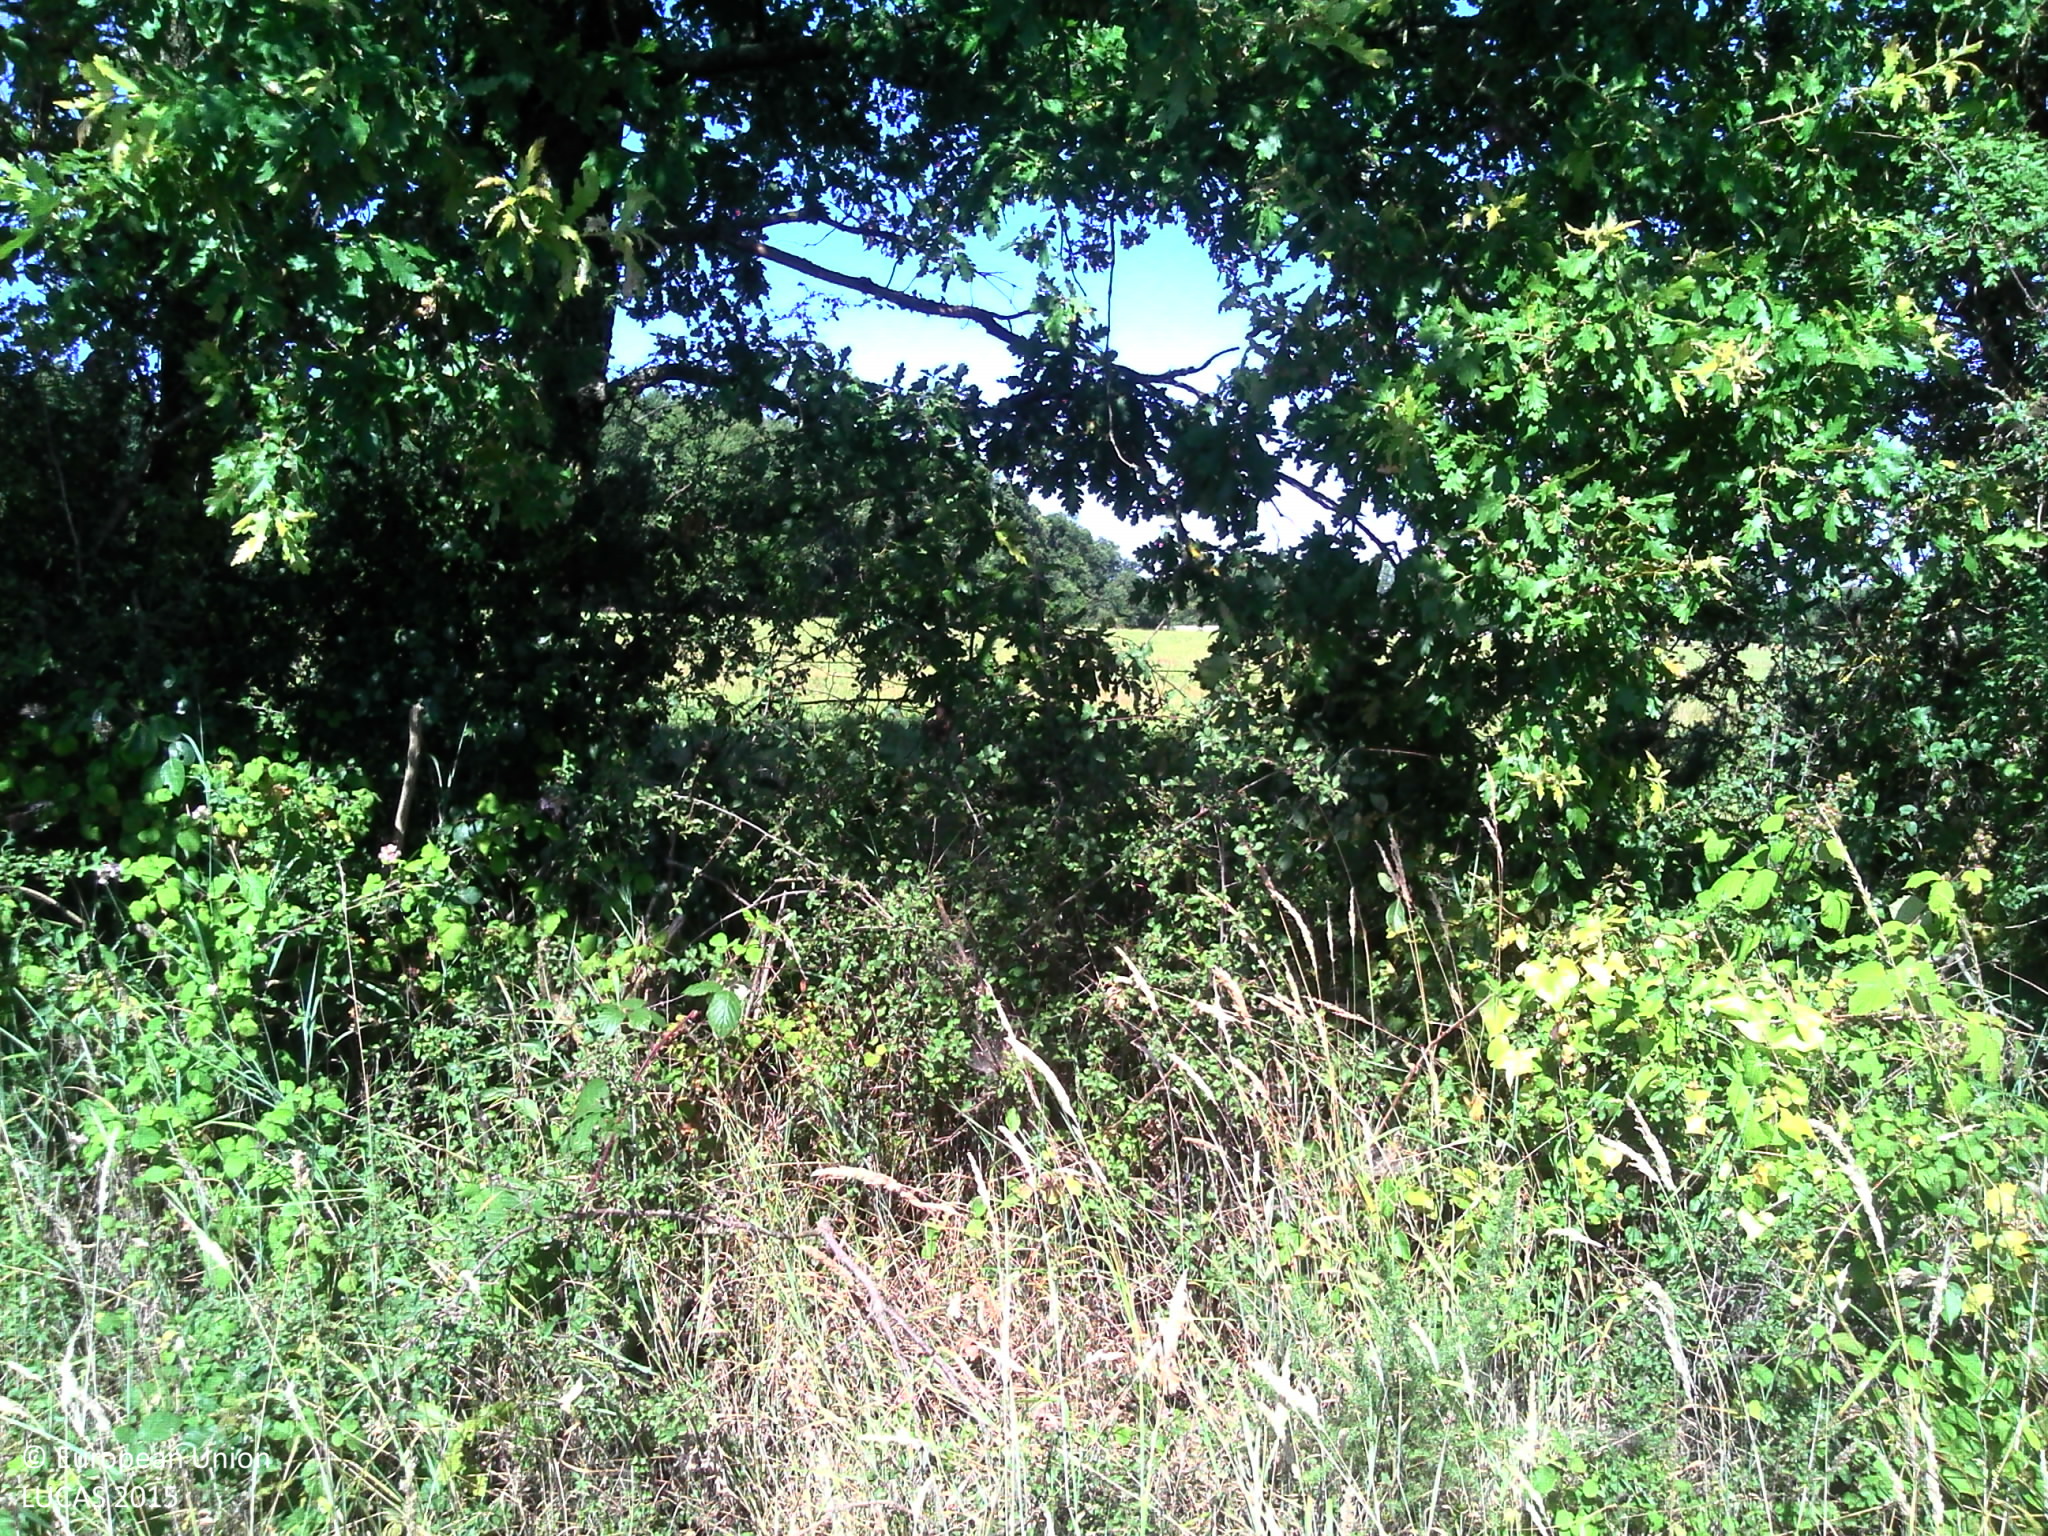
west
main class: Grassland
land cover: Grassland without tree/shrub cover
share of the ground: > 75 %
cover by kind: herbaceous plants 100 %
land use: Agriculture (excluding fallow land and kitchen gardens)
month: June
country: FR
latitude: 46.4685
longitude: 0.8827
